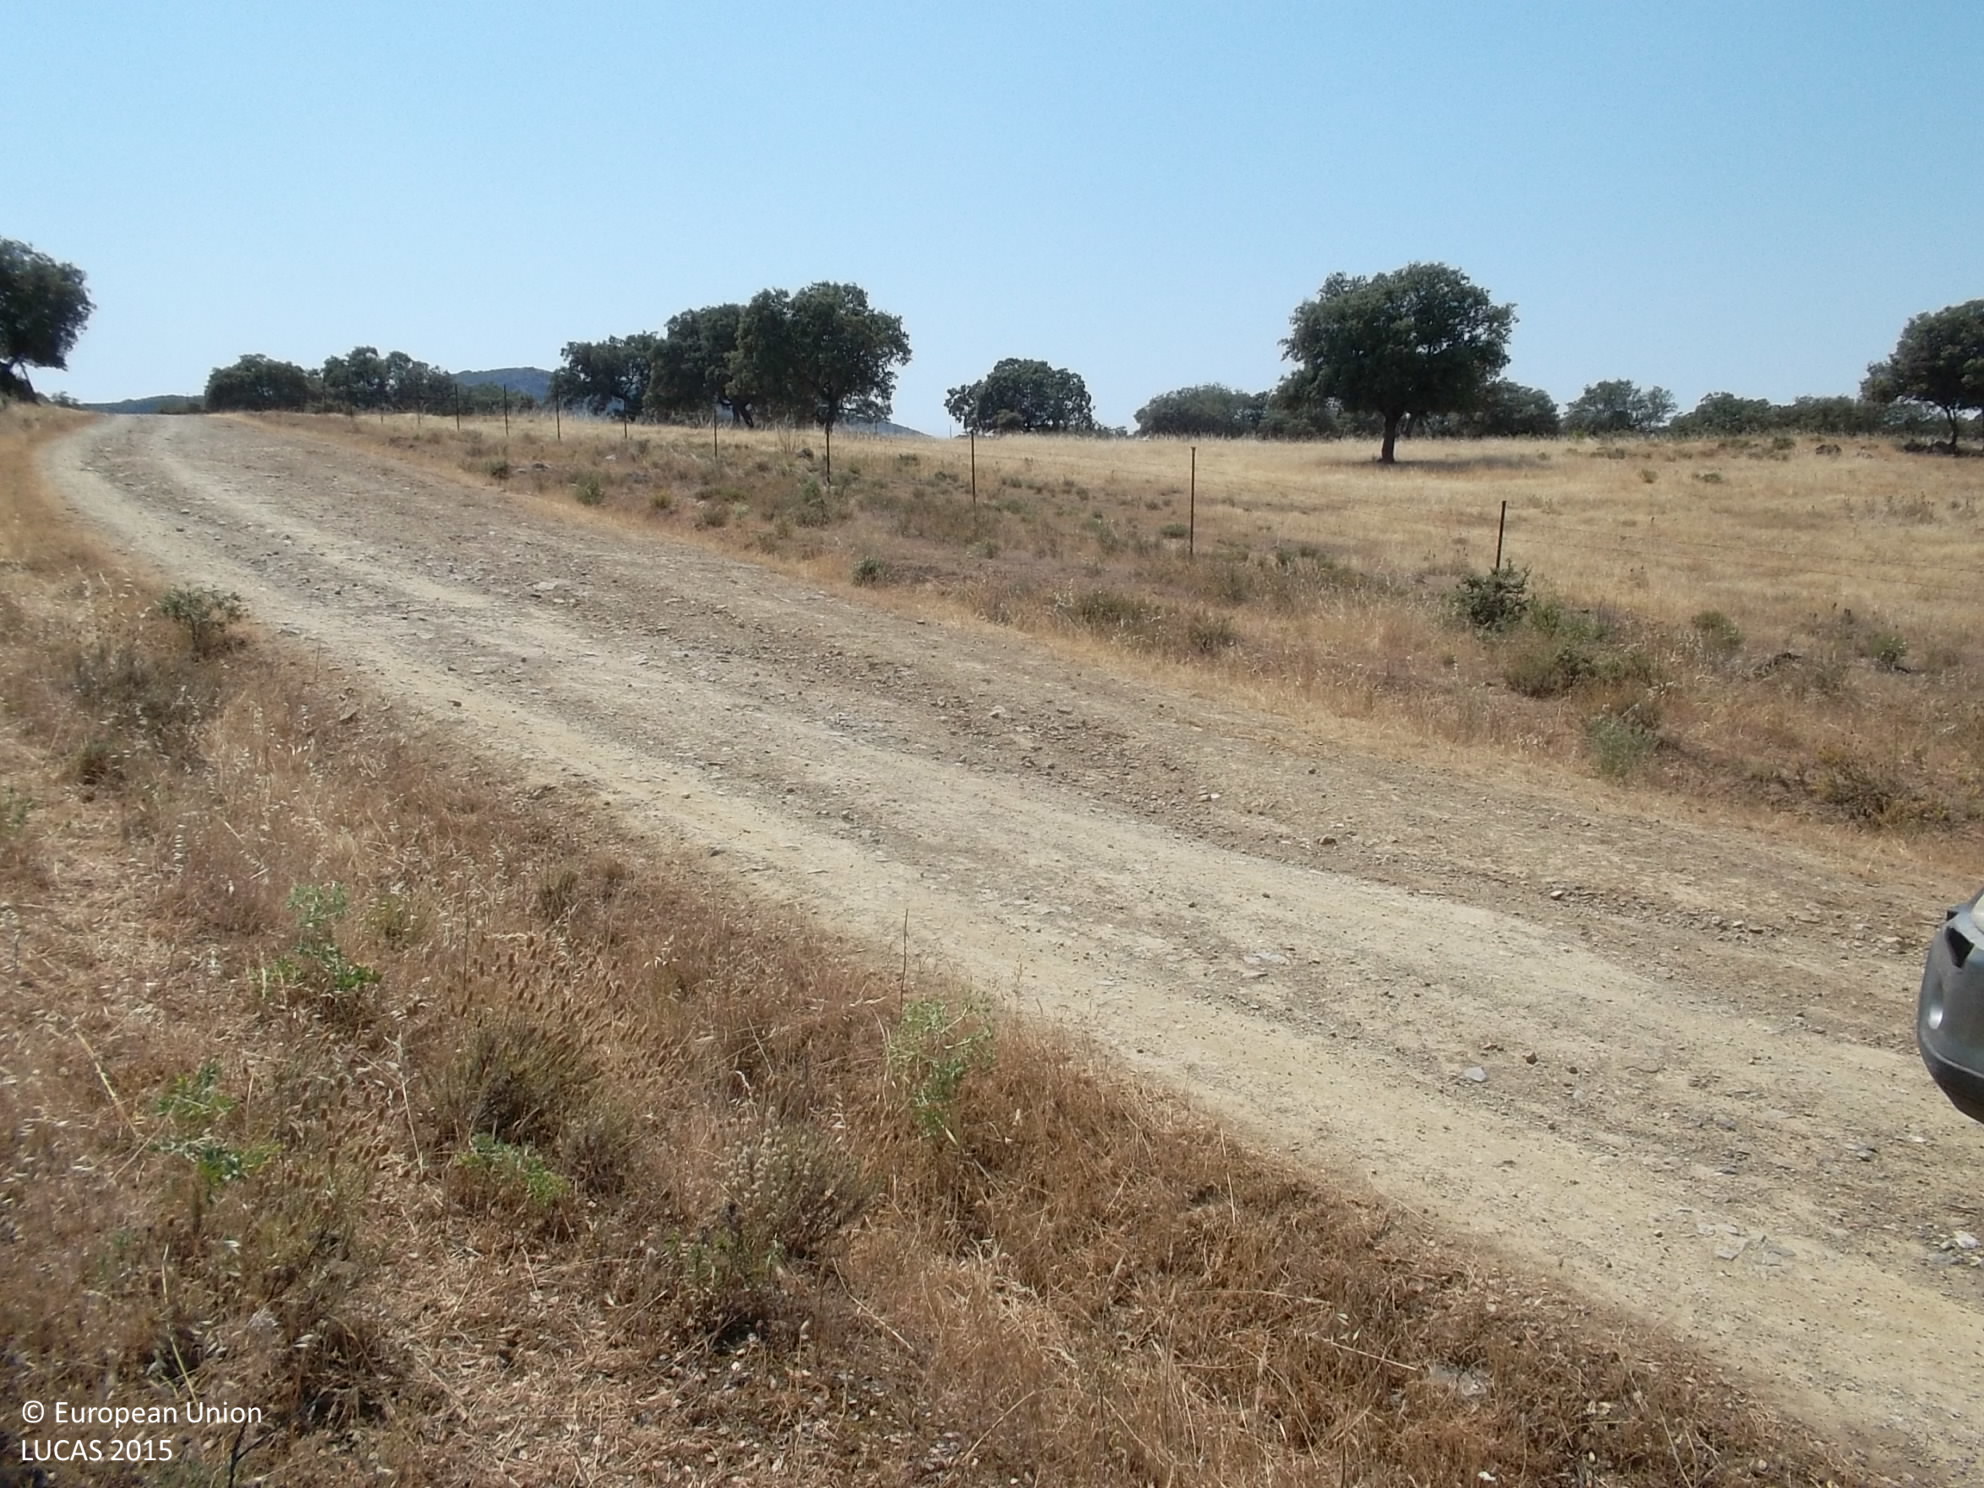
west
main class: Woodland
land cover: Broadleaved woodland
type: broadleaved evergreen forest
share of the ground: 25 - 50 %
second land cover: Spontaneously vegetated surfaces
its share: > 75 %
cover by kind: herbaceous plants 60 %, broadleaved forest trees 30 %, shrubs 10 %
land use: Forestry
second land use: Agriculture (excluding fallow land and kitchen gardens)
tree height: > 5 m
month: June
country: ES
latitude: 39.1332
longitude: -4.9487
